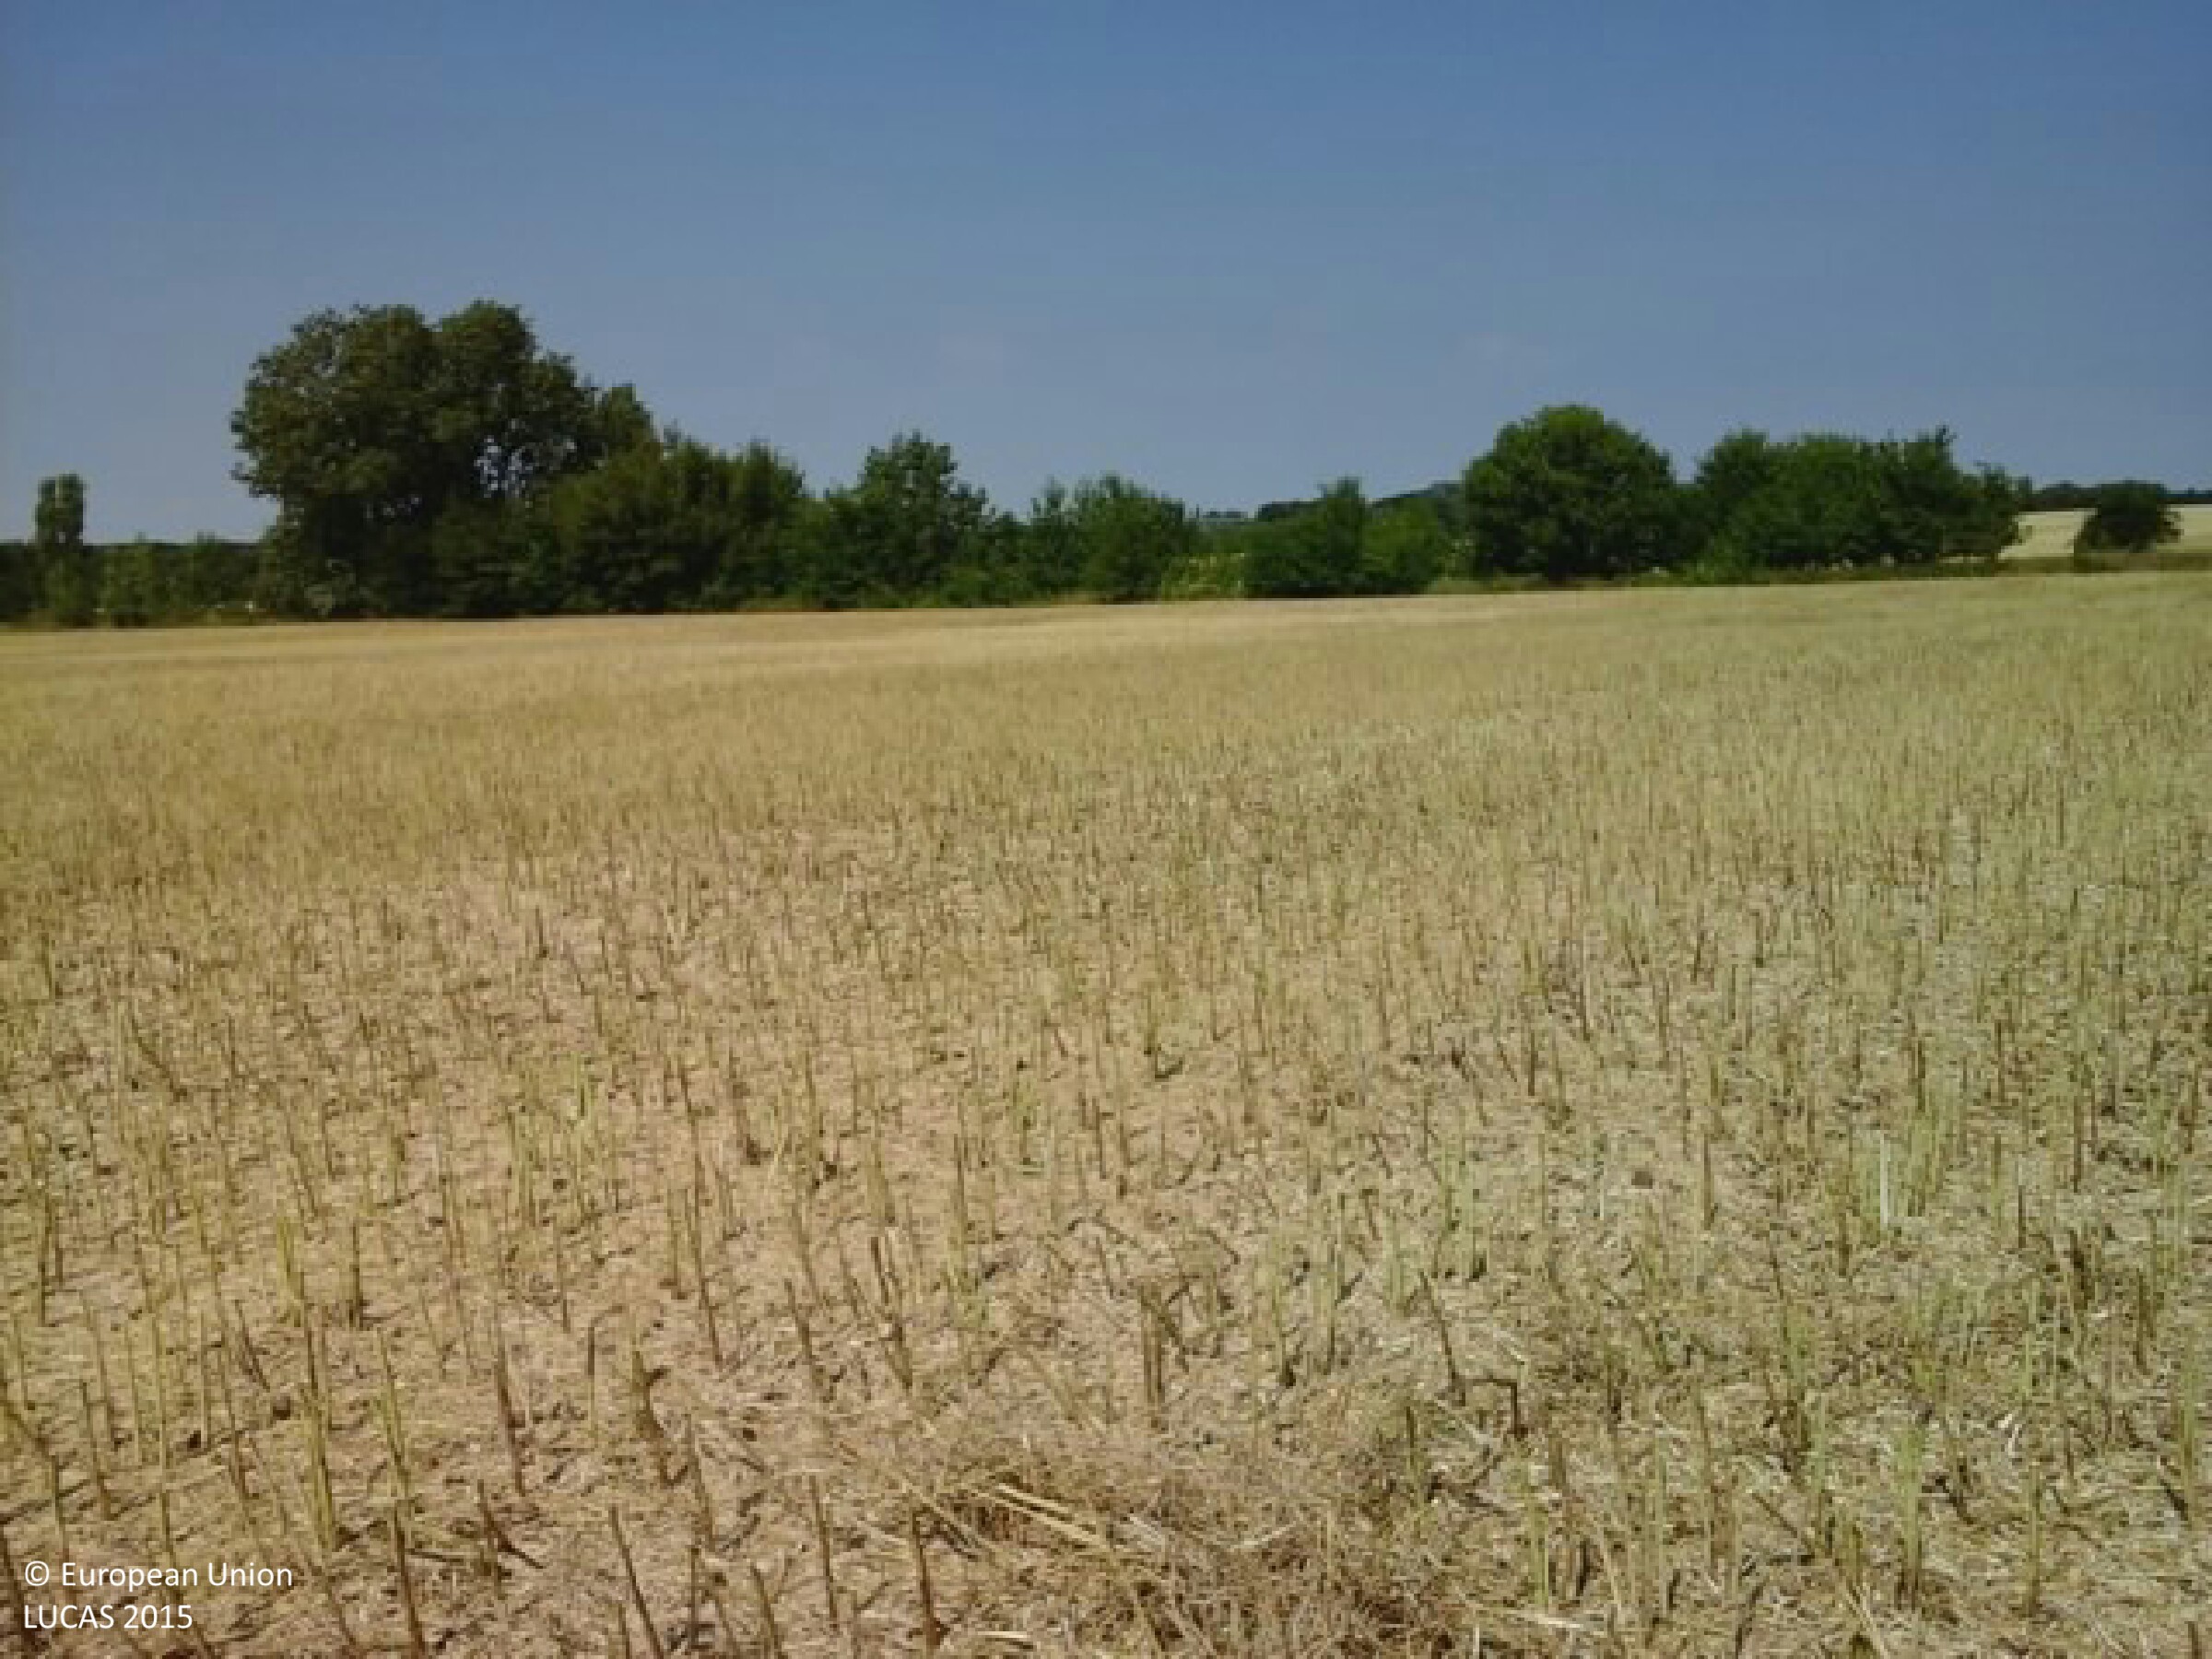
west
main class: Cropland
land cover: Rape and turnip rape
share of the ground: > 75 %
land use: Agriculture (excluding fallow land and kitchen gardens)
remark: Harvested field
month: June
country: HU
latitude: 47.4501
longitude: 19.2901
